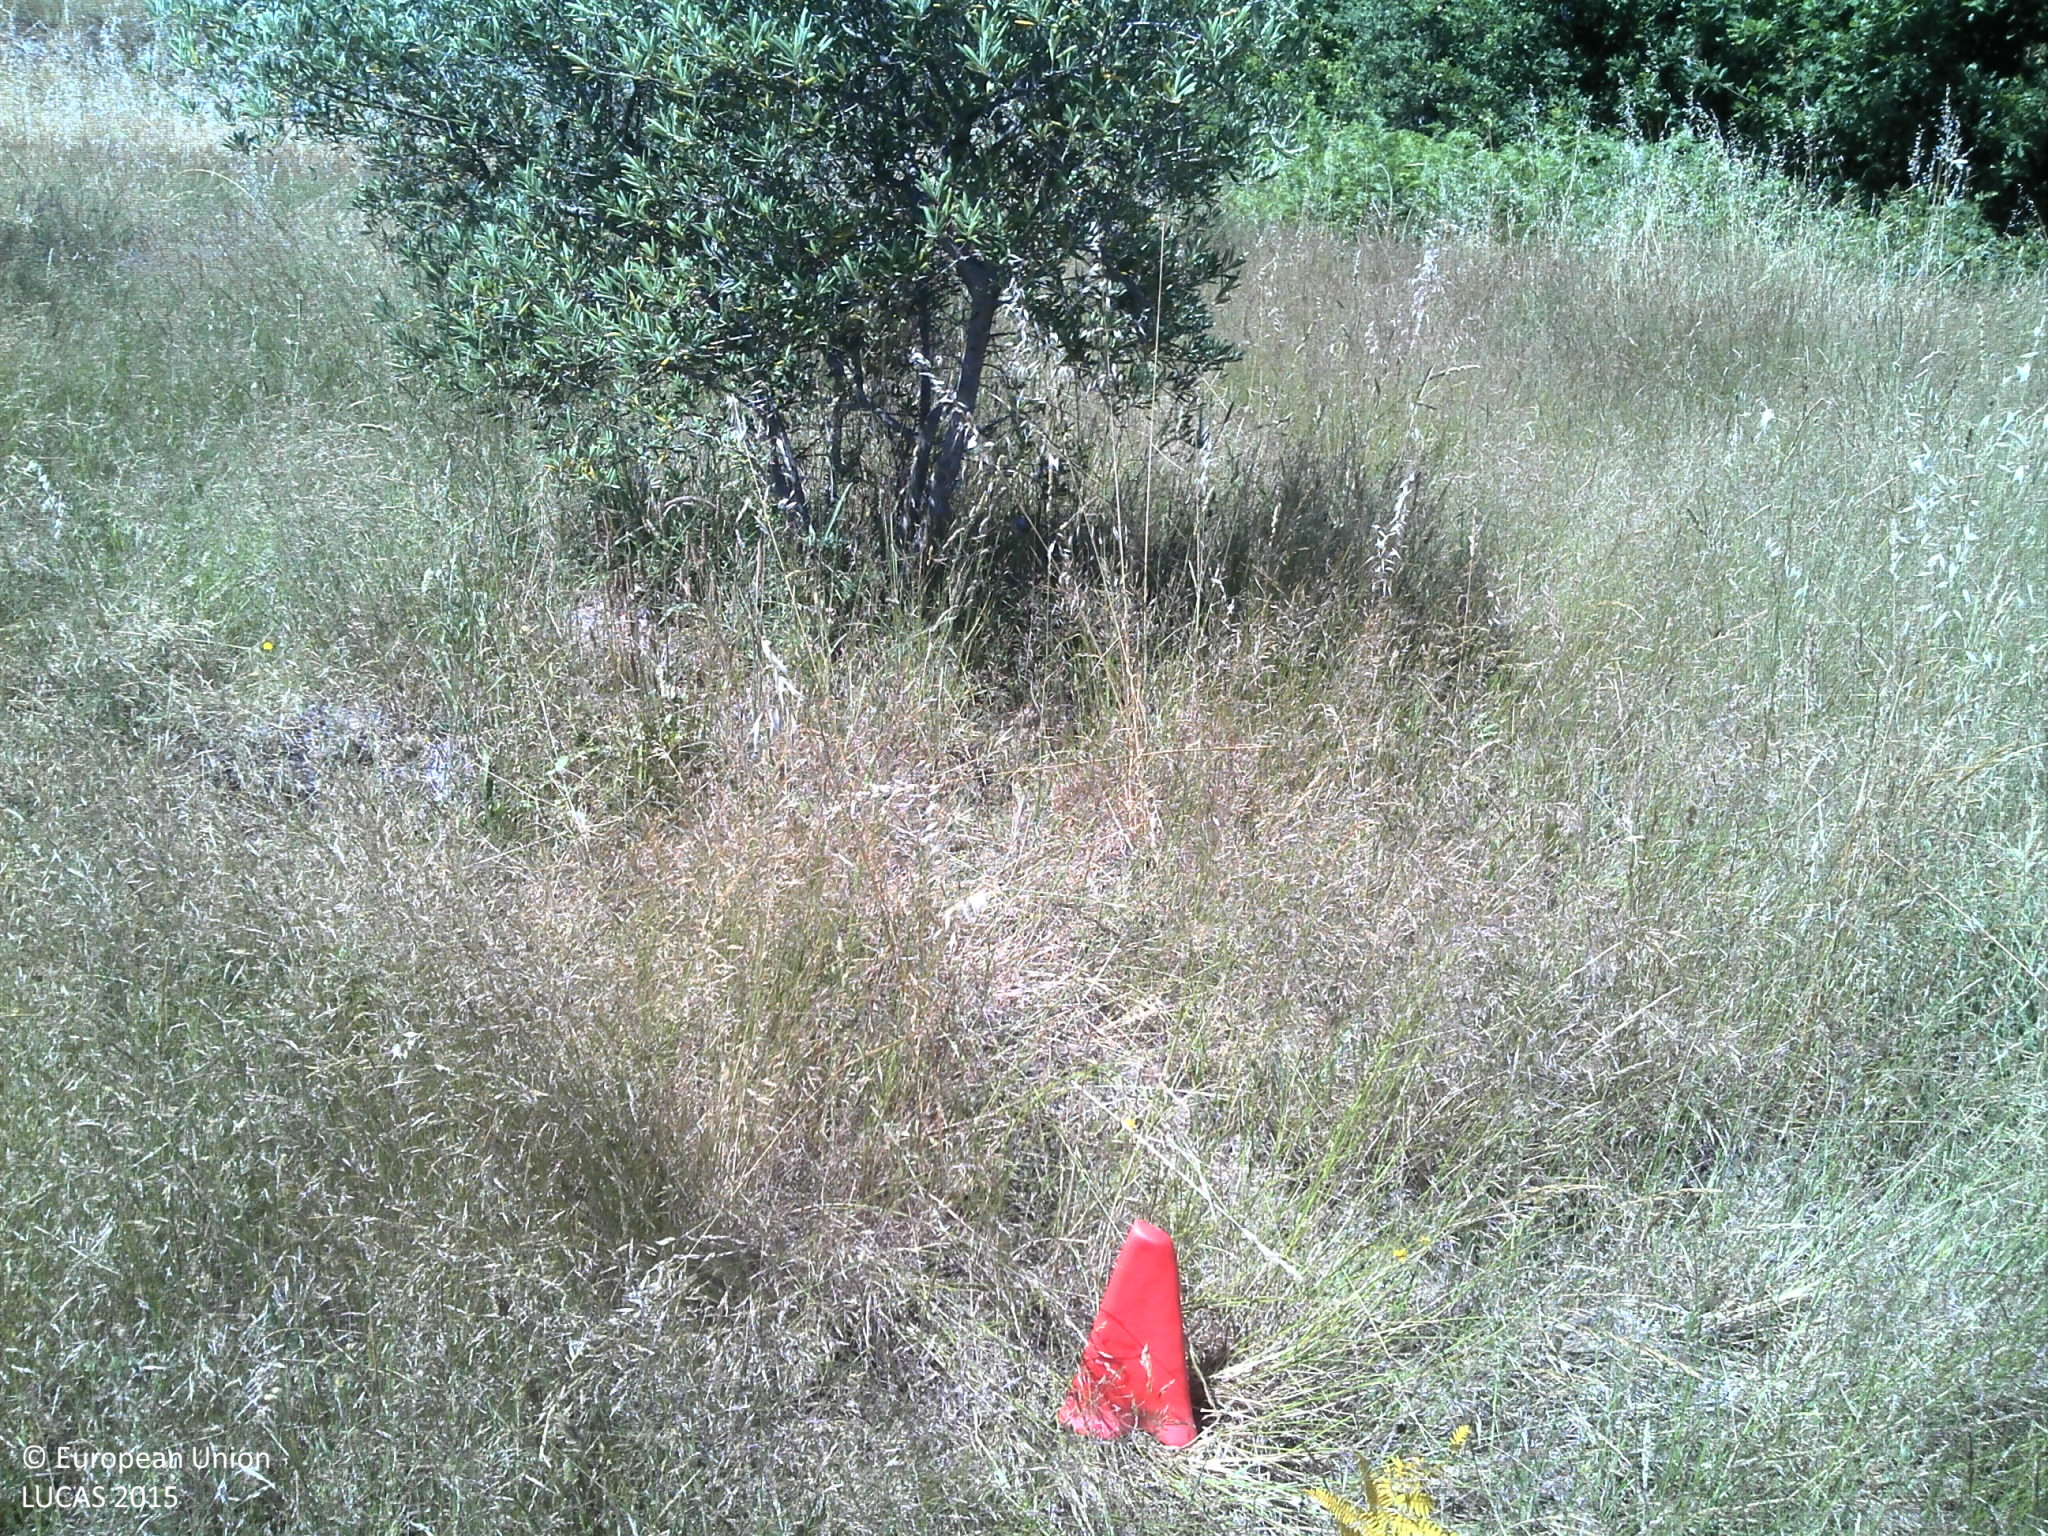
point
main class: Cropland
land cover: Olive groves
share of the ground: 10 - 25 %
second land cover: Grassland without tree/shrub cover
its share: > 75 %
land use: Agriculture (excluding fallow land and kitchen gardens)
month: June
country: PT
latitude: 40.6690
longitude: -7.8312
